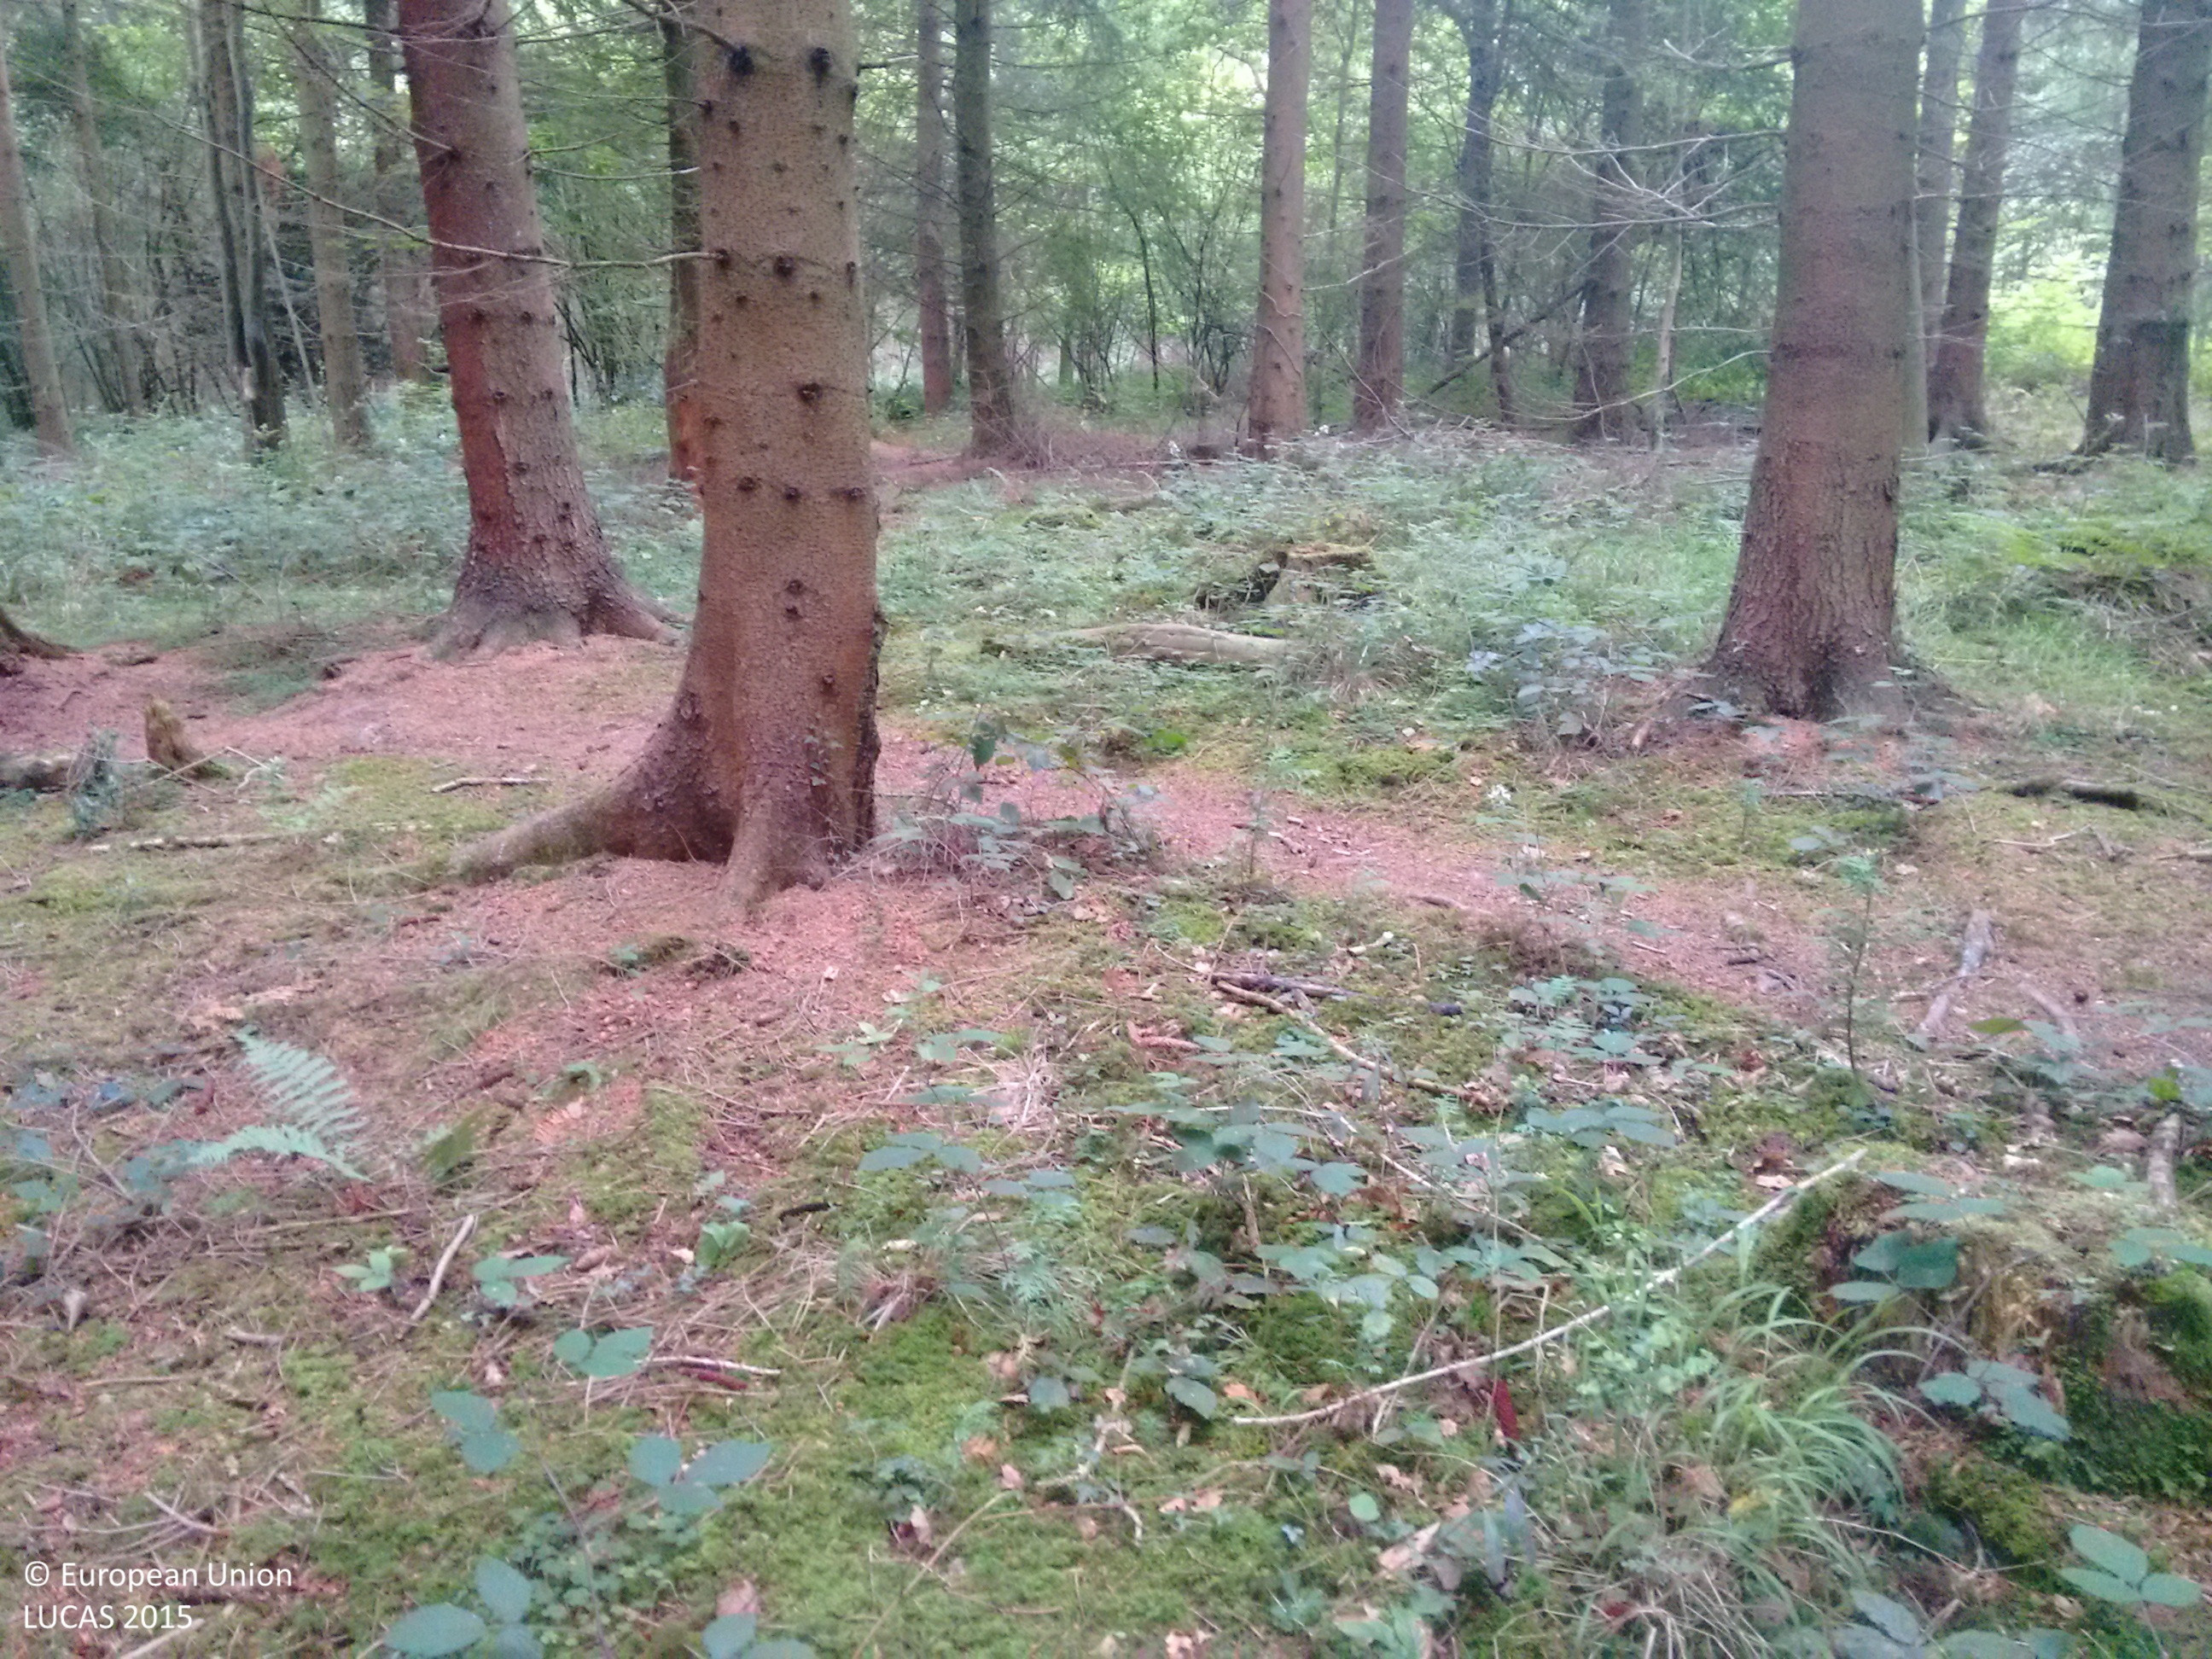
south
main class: Woodland
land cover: Spruce dominated mixed woodland
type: exotic forest
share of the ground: > 75 %
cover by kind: coniferous forest trees 70 %, broadleaved forest trees 25 %, shrubs 5 %
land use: Forestry
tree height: > 5 m
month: July
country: GB
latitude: 52.0316
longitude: -2.5888
